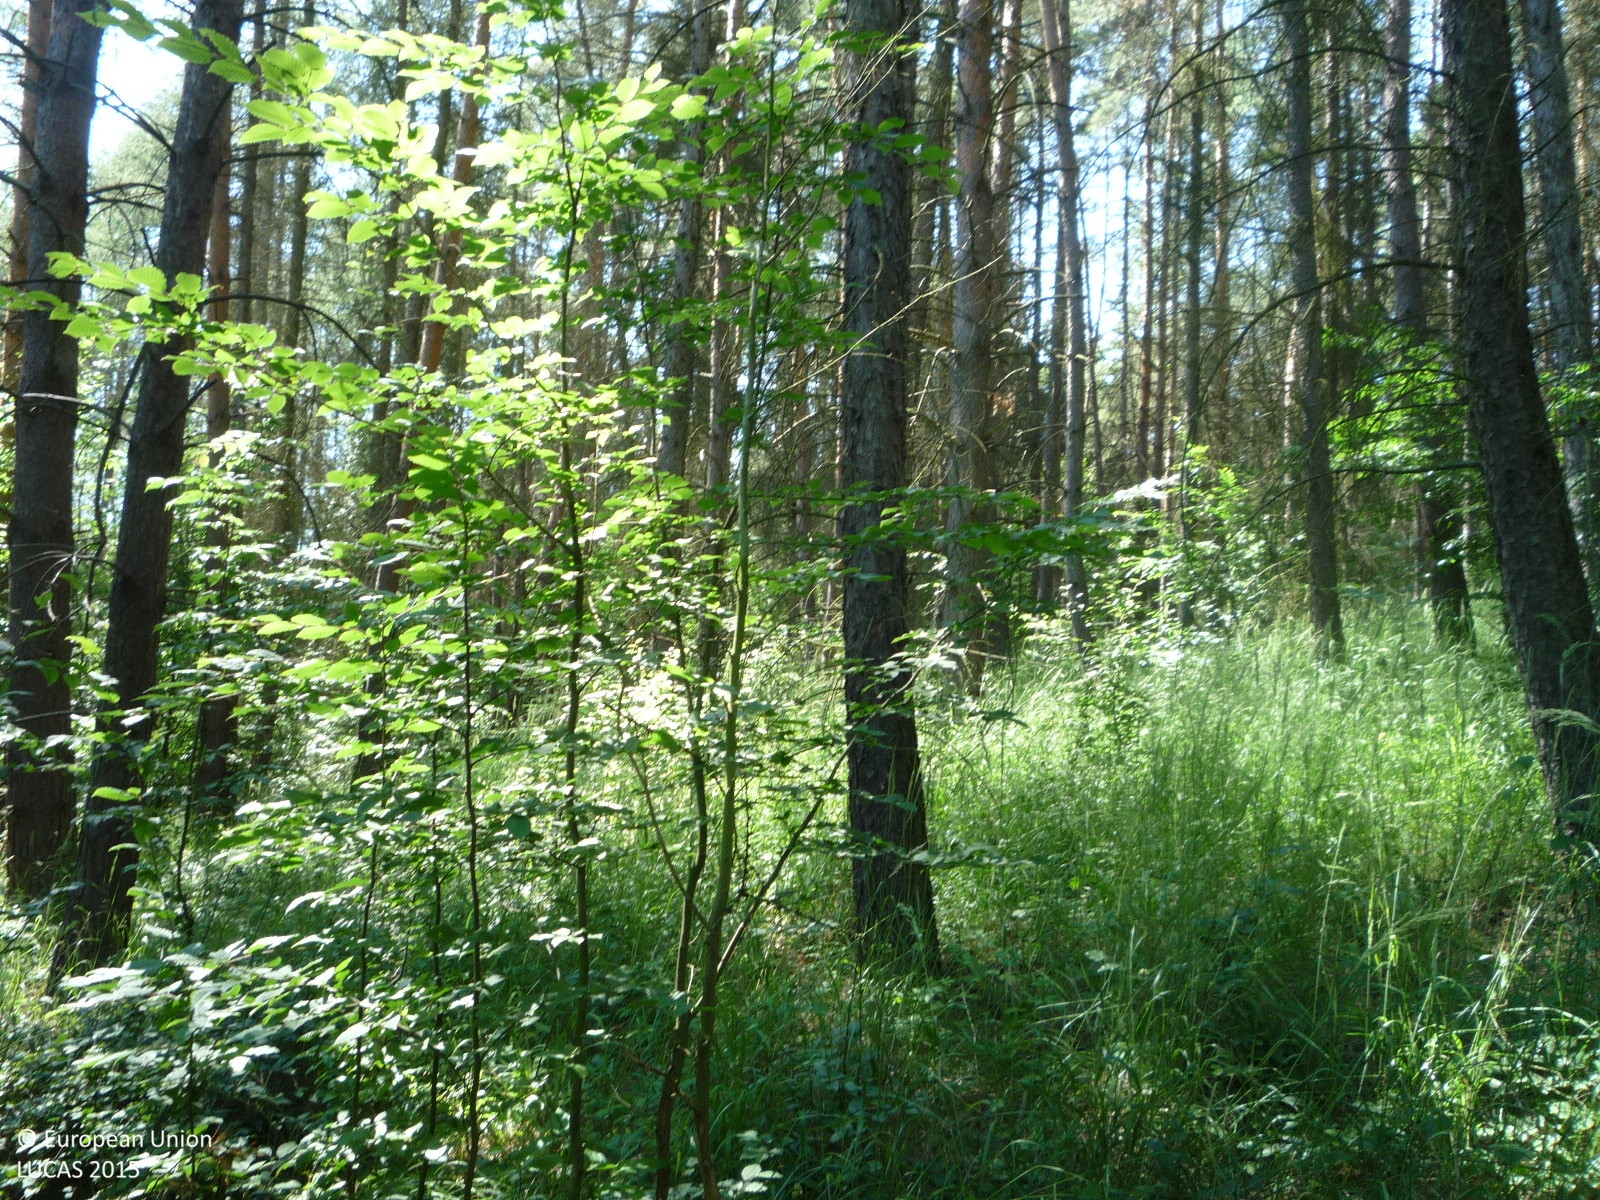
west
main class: Woodland
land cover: Other coniferous woodland
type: hemiboreal forest and nemoral coniferous forest and mixed broadleaved-coniferous forest
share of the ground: > 75 %
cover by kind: coniferous forest trees 90 %, broadleaved forest trees 5 %, herbaceous plants 5 %
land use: Forestry
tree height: > 5 m
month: July
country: CZ
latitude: 50.4727
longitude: 14.5248
